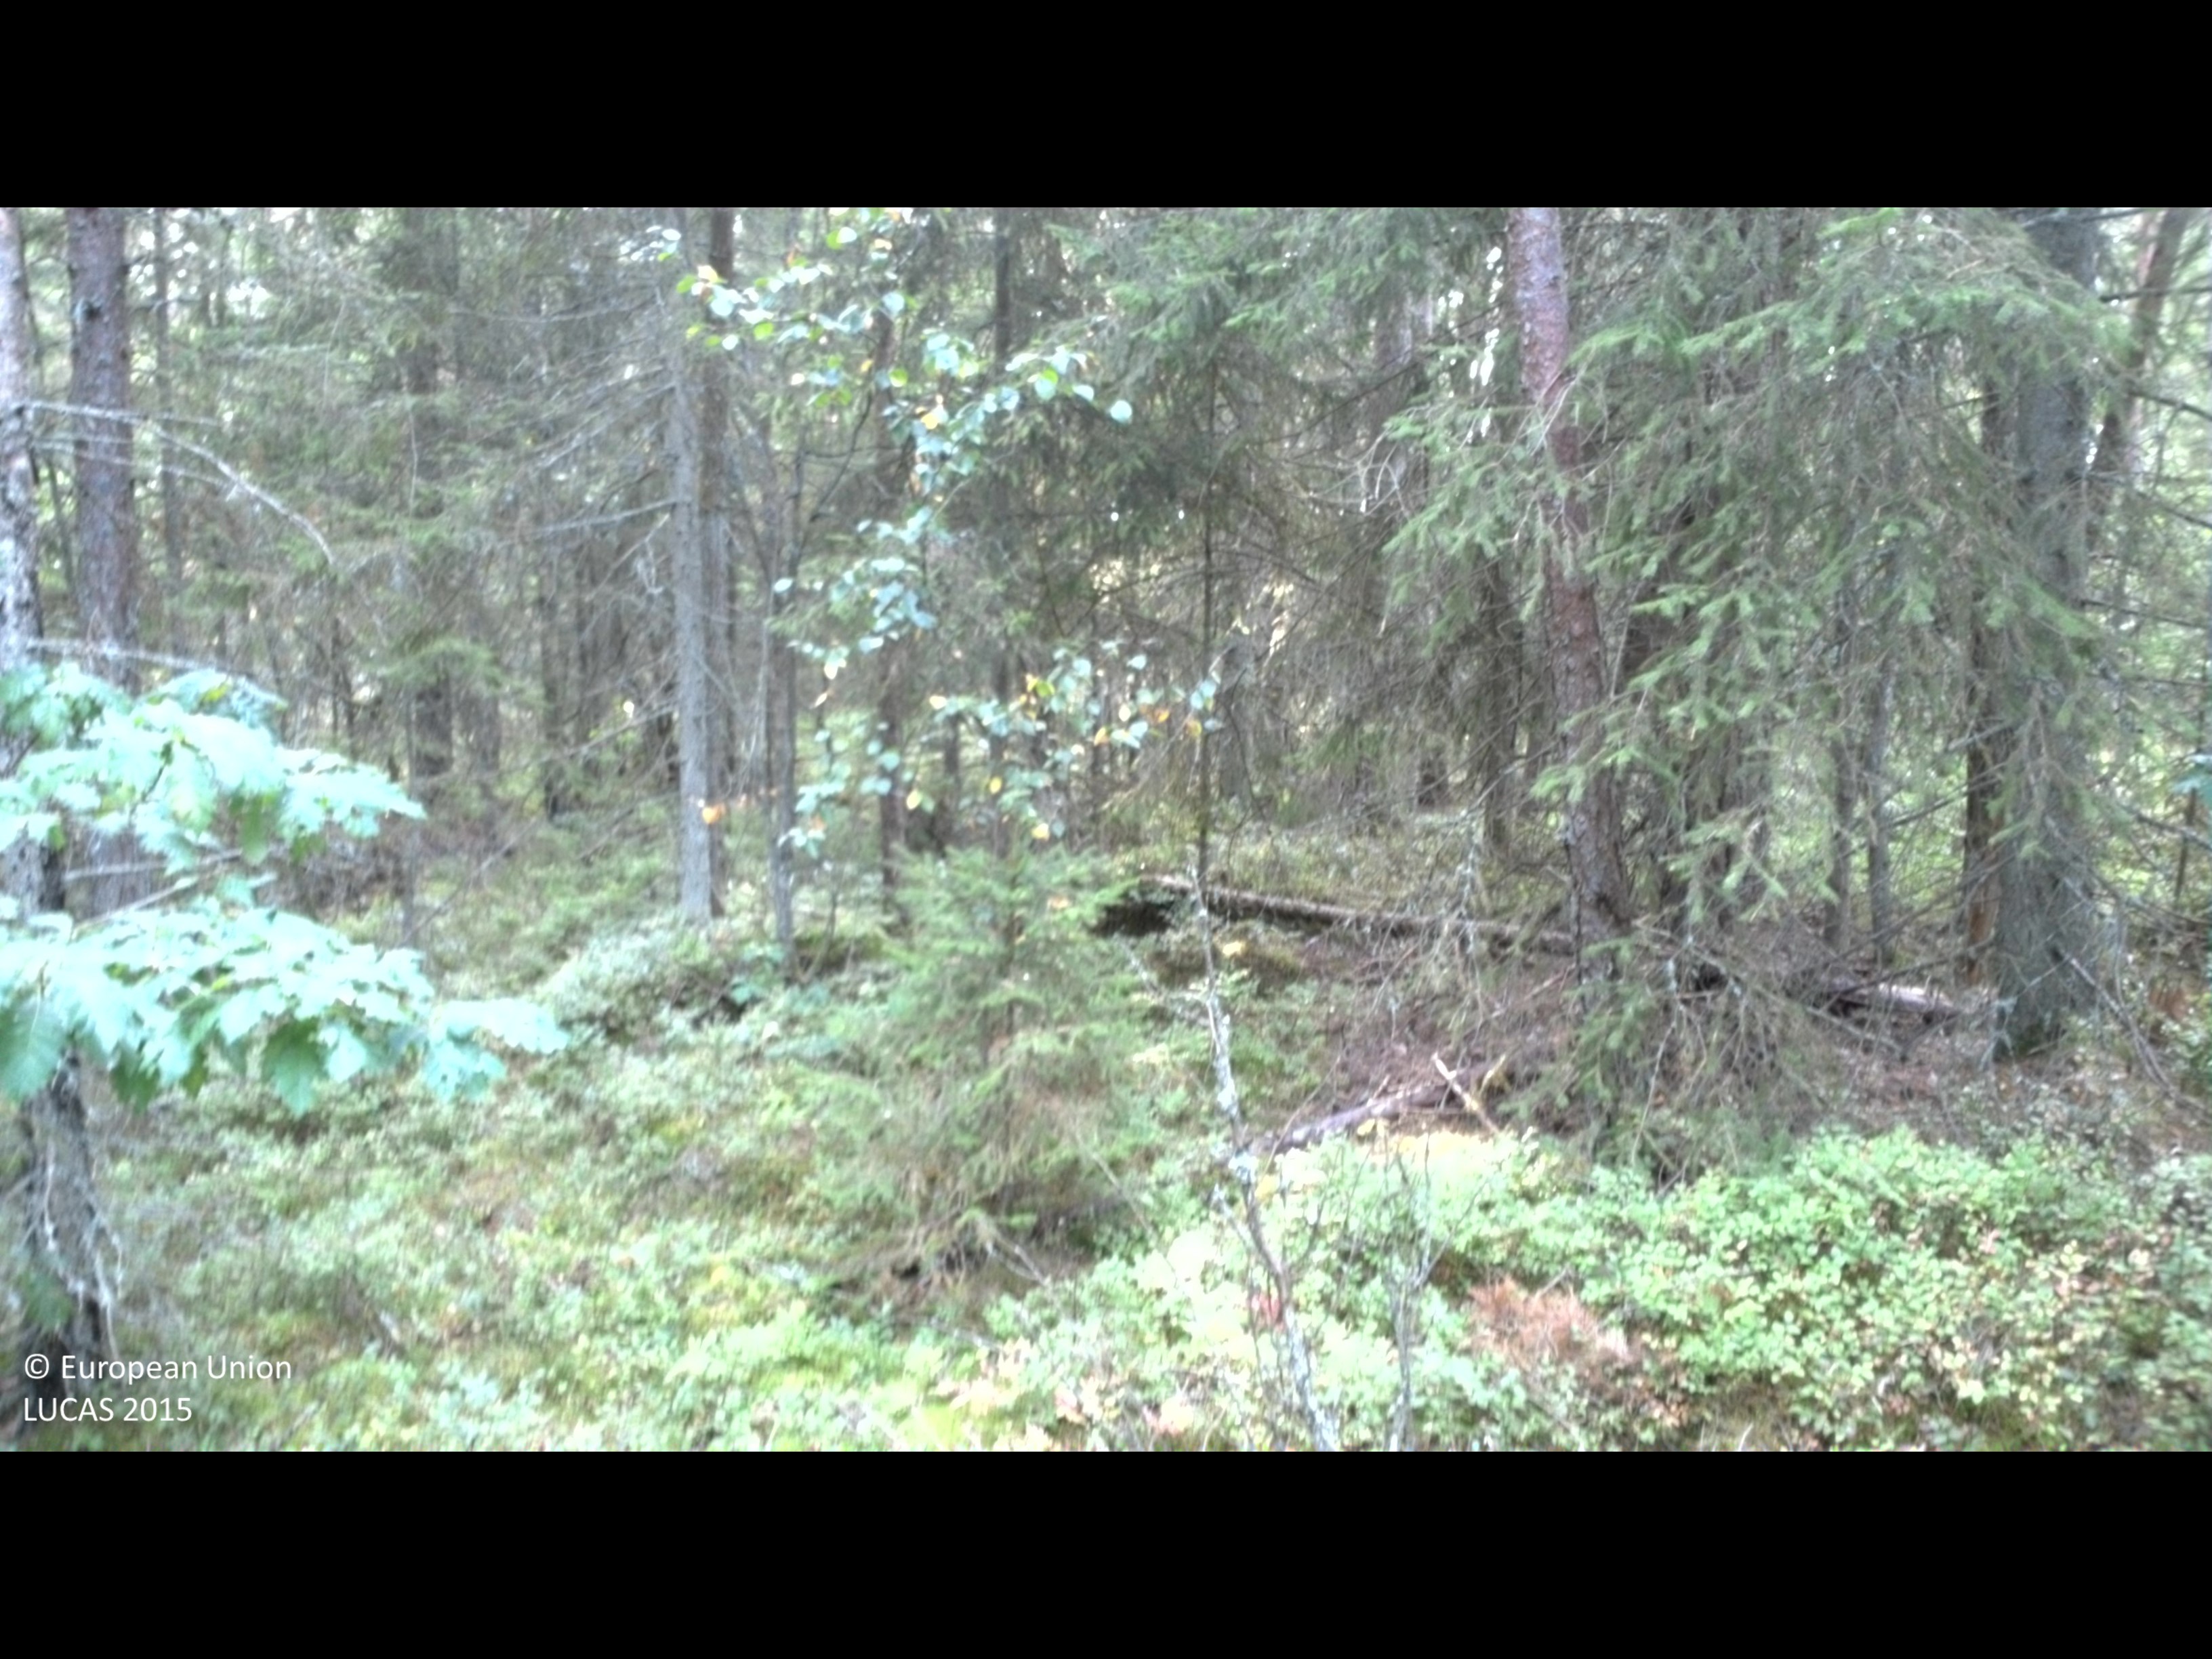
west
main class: Woodland
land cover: Spruce dominated coniferous woodland
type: boreal forest
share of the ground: 25 - 50 %
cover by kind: lichens and mosses 50 %, coniferous forest trees 35 %, shrubs 15 %
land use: Forestry
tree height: > 5 m
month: August
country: SE
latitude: 56.1725
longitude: 15.2015
